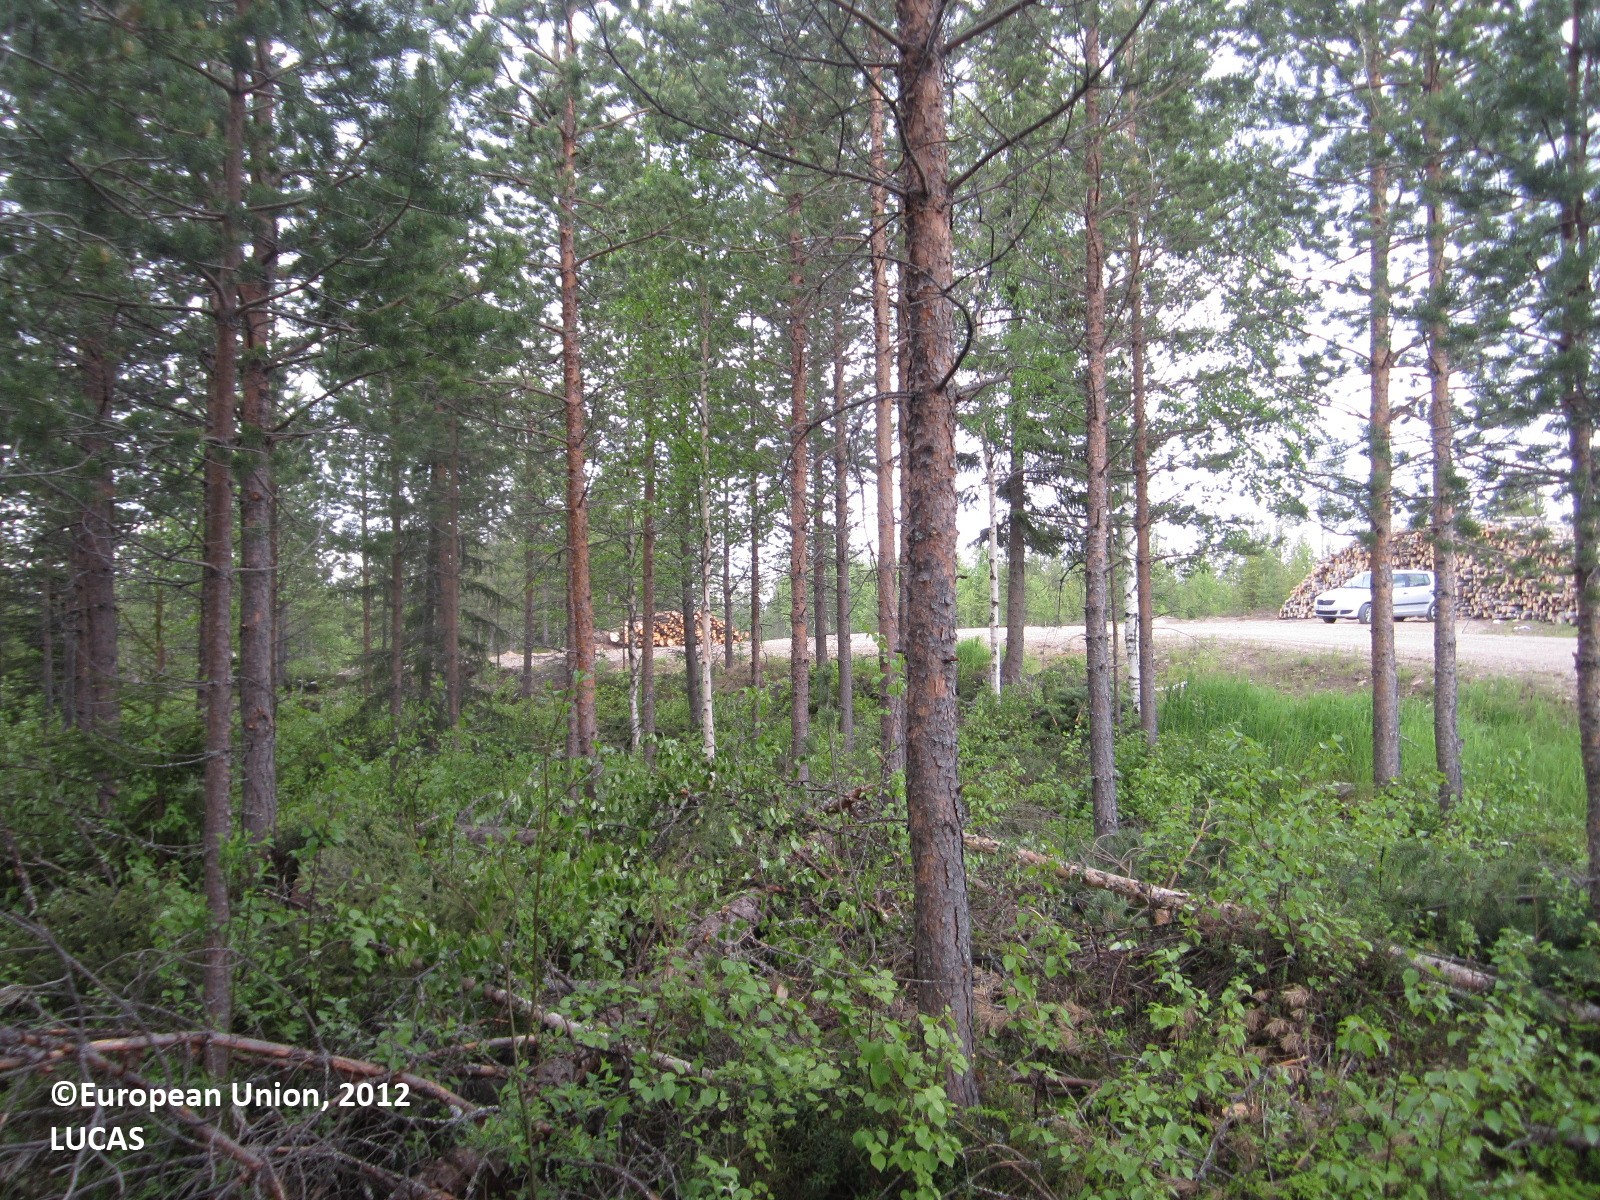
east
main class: Woodland
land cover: Pine dominated mixed woodland
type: boreal forest
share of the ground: > 75 %
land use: Forestry
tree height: > 5 m
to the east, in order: Pine dominated mixed woodland; Ditches and canals; Pine dominated mixed woodland; Artificial constructions in urban areas; Pine dominated mixed woodland
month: June
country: FI
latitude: 65.0247
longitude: 29.1912
